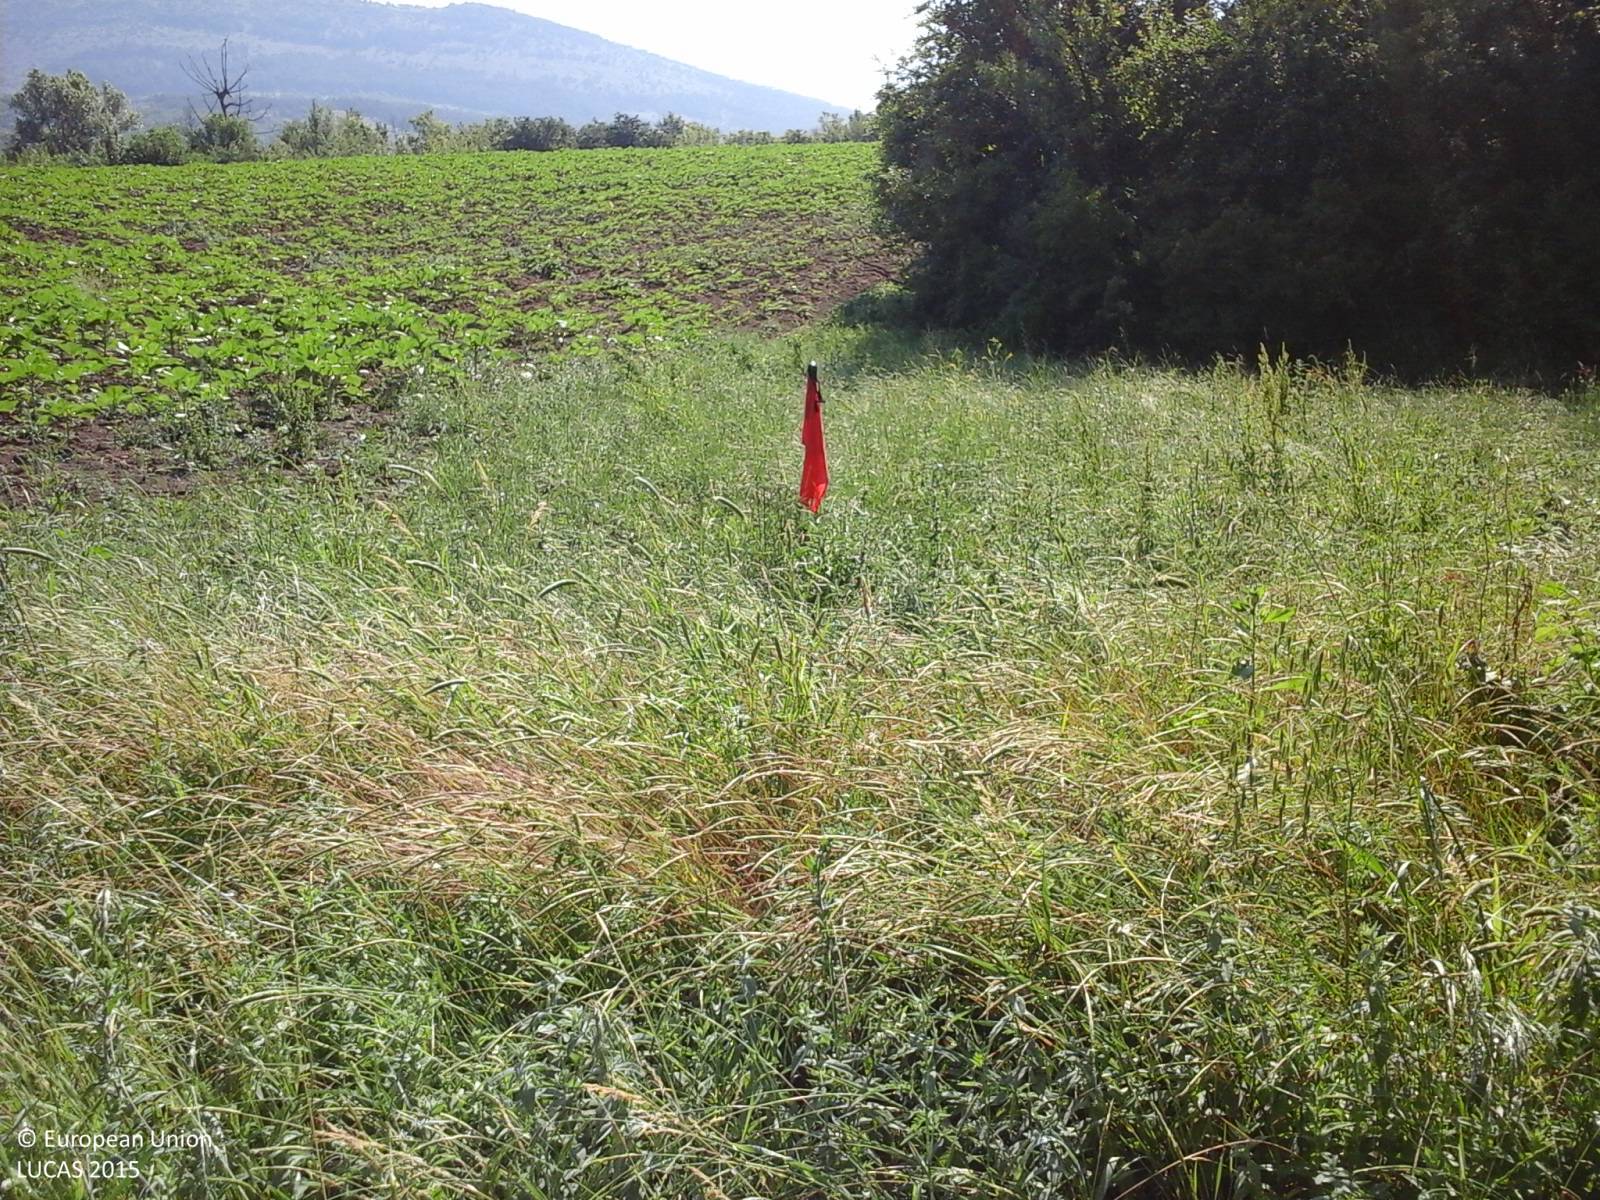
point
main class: Grassland
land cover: Spontaneously vegetated surfaces
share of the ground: > 75 %
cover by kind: herbaceous plants 100 %
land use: Fallow land
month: June
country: IT
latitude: 42.0965
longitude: 13.7478
